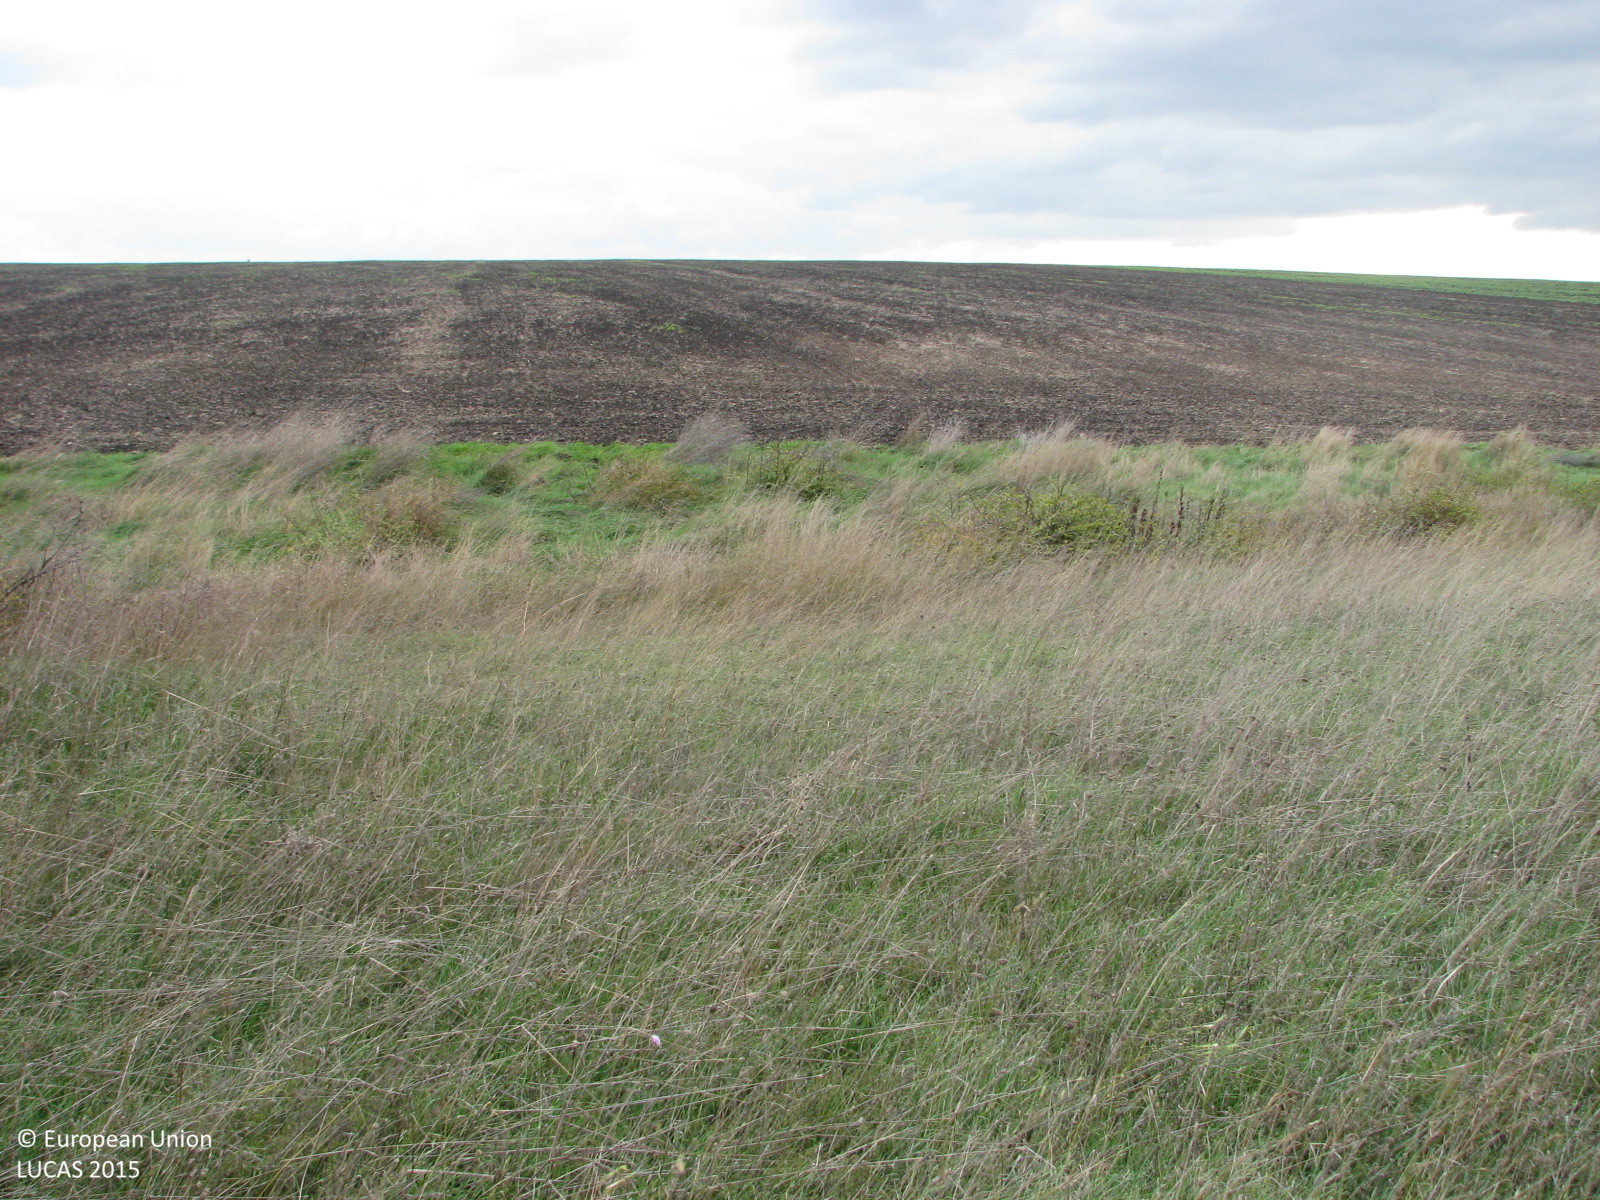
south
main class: Grassland
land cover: Grassland with sparse tree/shrub cover
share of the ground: > 75 %
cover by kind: herbaceous plants 90 %, broadleaved forest trees 5 %, shrubs 5 %
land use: Semi-natural and natural areas not in use
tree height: < 5 m
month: October
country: BG
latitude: 42.2304
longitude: 26.7056
